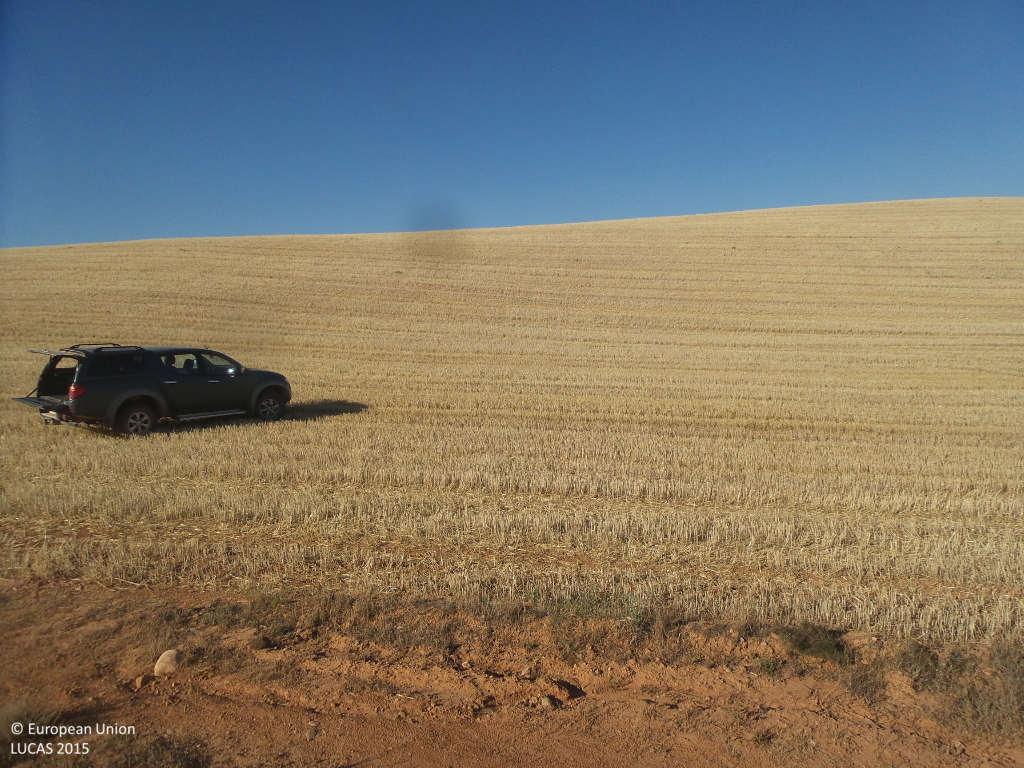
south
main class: Shrubland
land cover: Shrubland without tree cover
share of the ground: 25 - 50 %
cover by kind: unconsolidated bare surface 50 %, shrubs 40 %, herbaceous plants 10 %
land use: Semi-natural and natural areas not in use
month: July
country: ES
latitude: 41.4031
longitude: -2.1962
